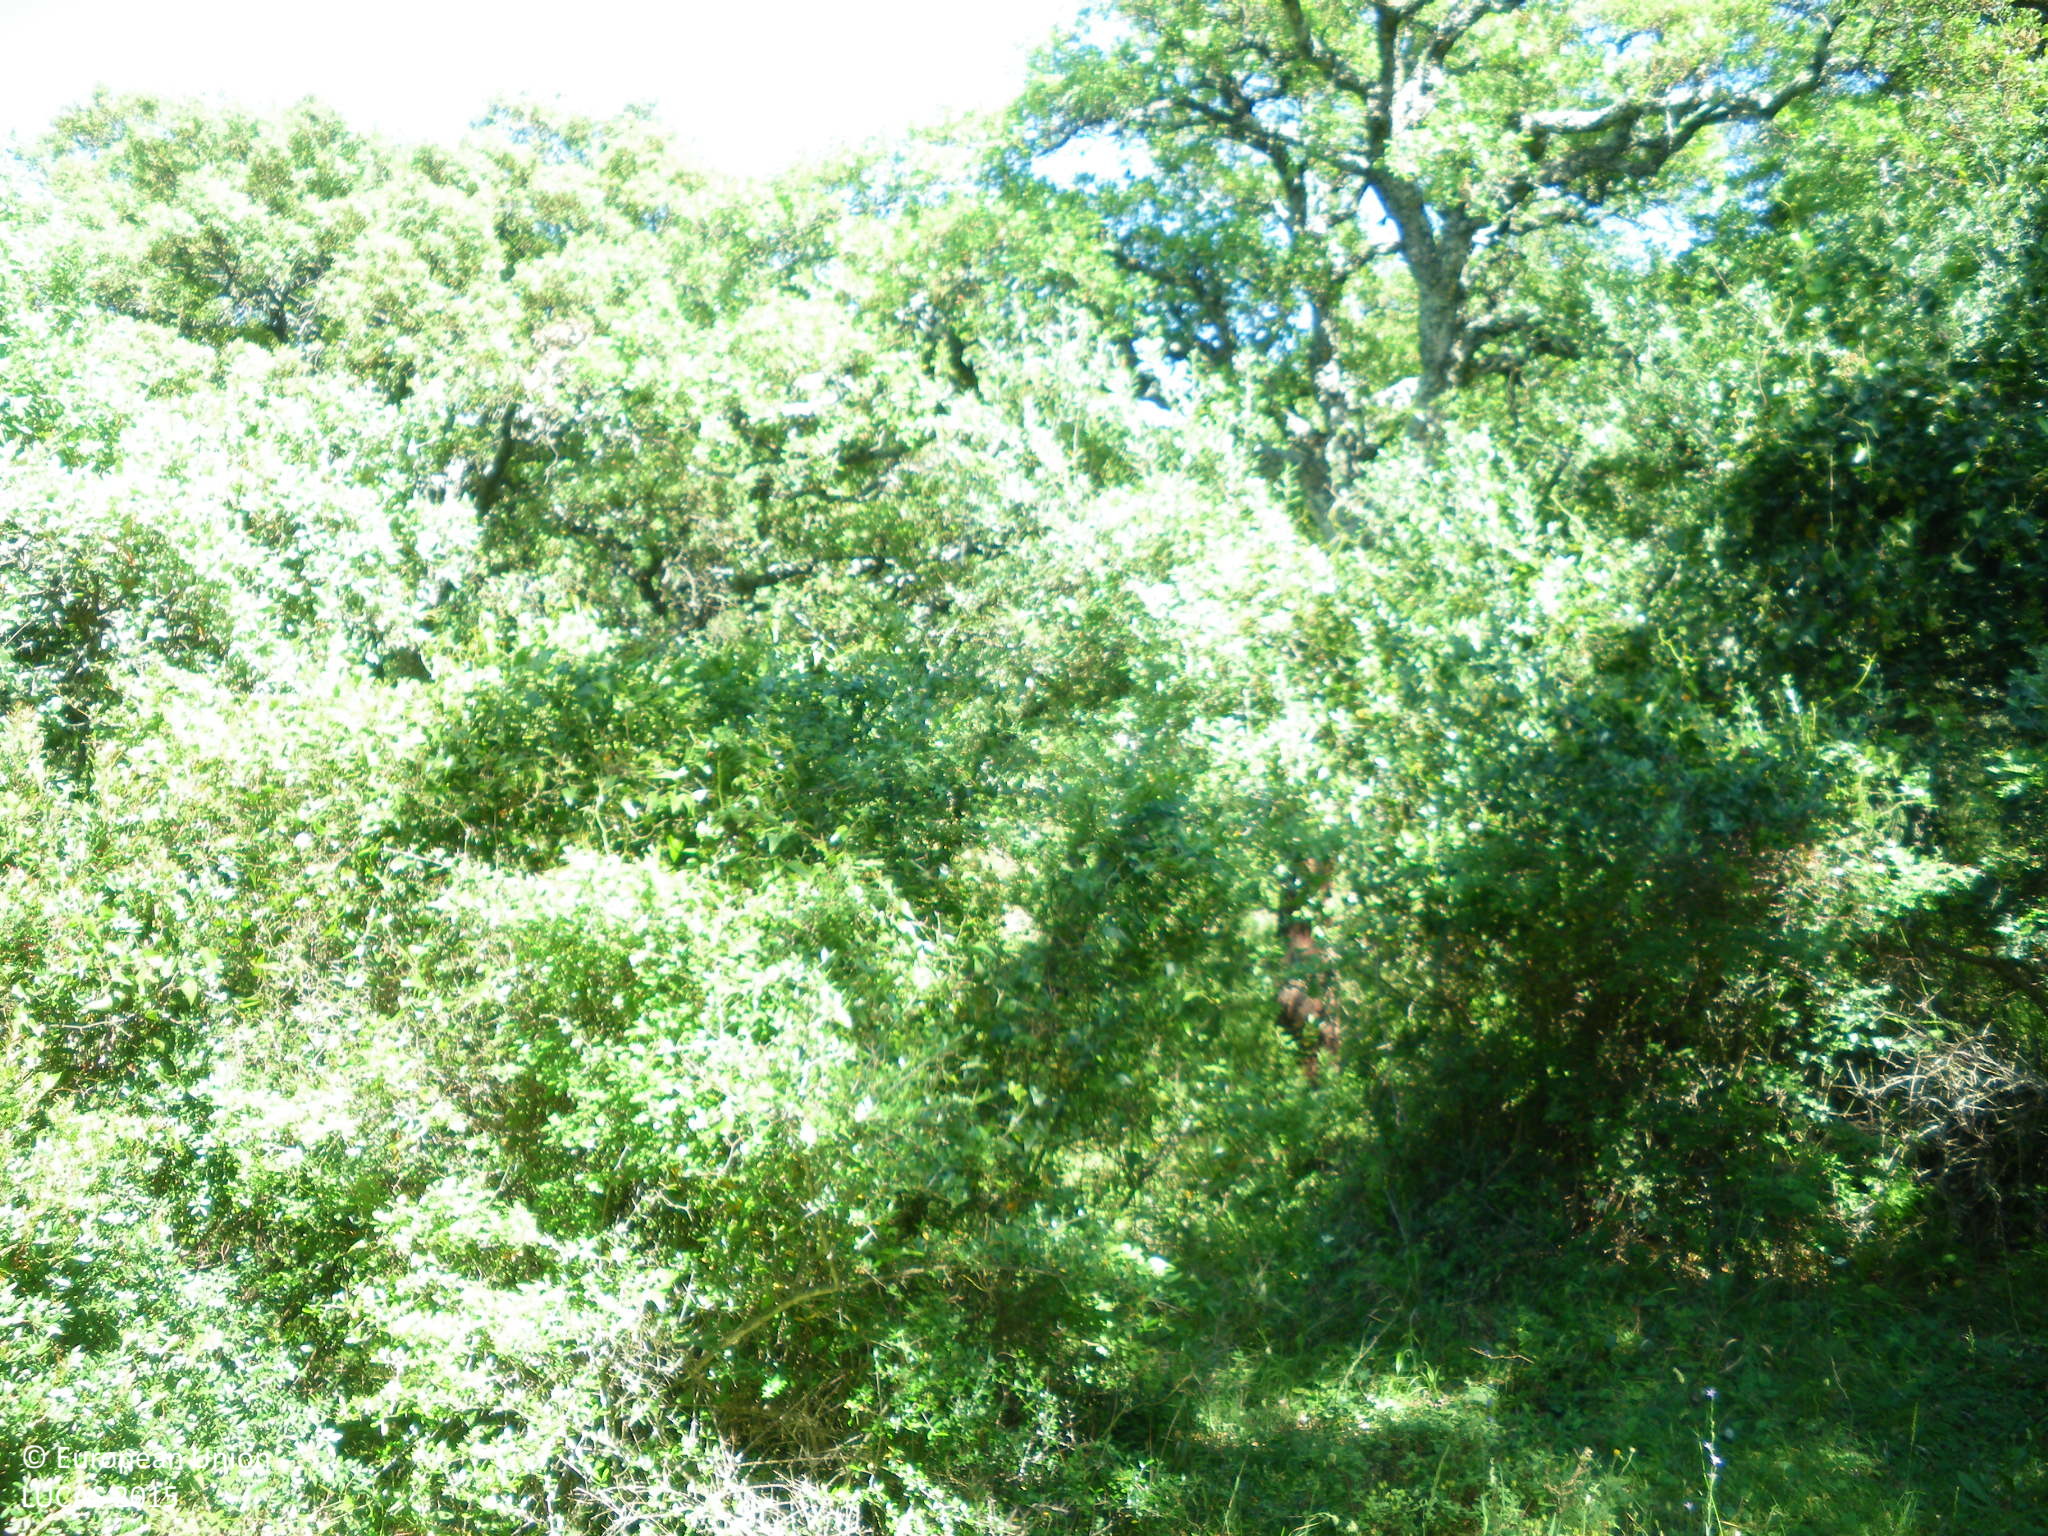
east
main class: Woodland
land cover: Broadleaved woodland
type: broadleaved evergreen forest
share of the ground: > 75 %
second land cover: Shrubland without tree cover
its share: 25 - 50 %
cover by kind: broadleaved forest trees 90 %, shrubs 10 %
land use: Forestry
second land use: Agriculture (excluding fallow land and kitchen gardens)
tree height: > 5 m
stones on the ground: < 10 %
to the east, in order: Broadleaved woodland; Shrubland without tree cover; Fences; Shrubland with sparse tree cover; Broadleaved woodland; Grassland with sparse tree/shrub cover
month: May
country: ES
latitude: 36.5174
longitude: -5.6462
